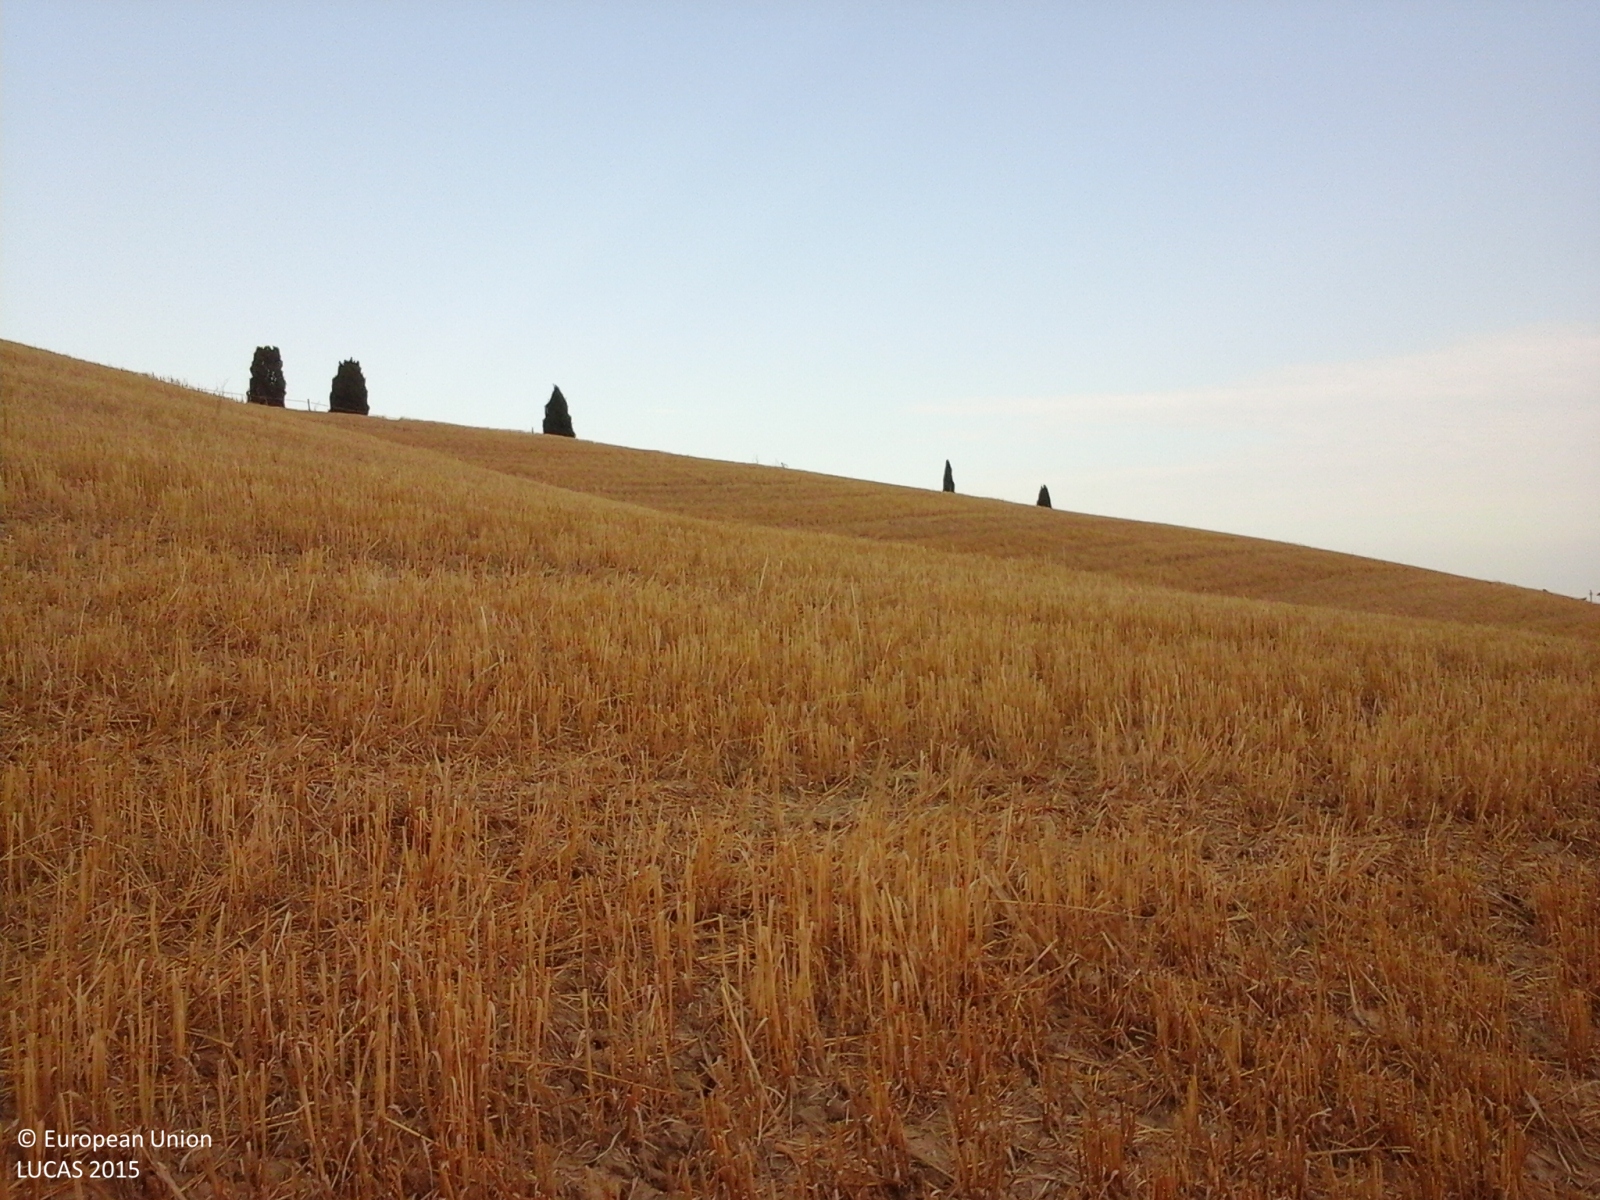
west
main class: Cropland
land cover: Durum wheat
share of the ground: > 75 %
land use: Agriculture (excluding fallow land and kitchen gardens)
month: July
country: IT
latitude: 43.2752
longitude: 11.4866
